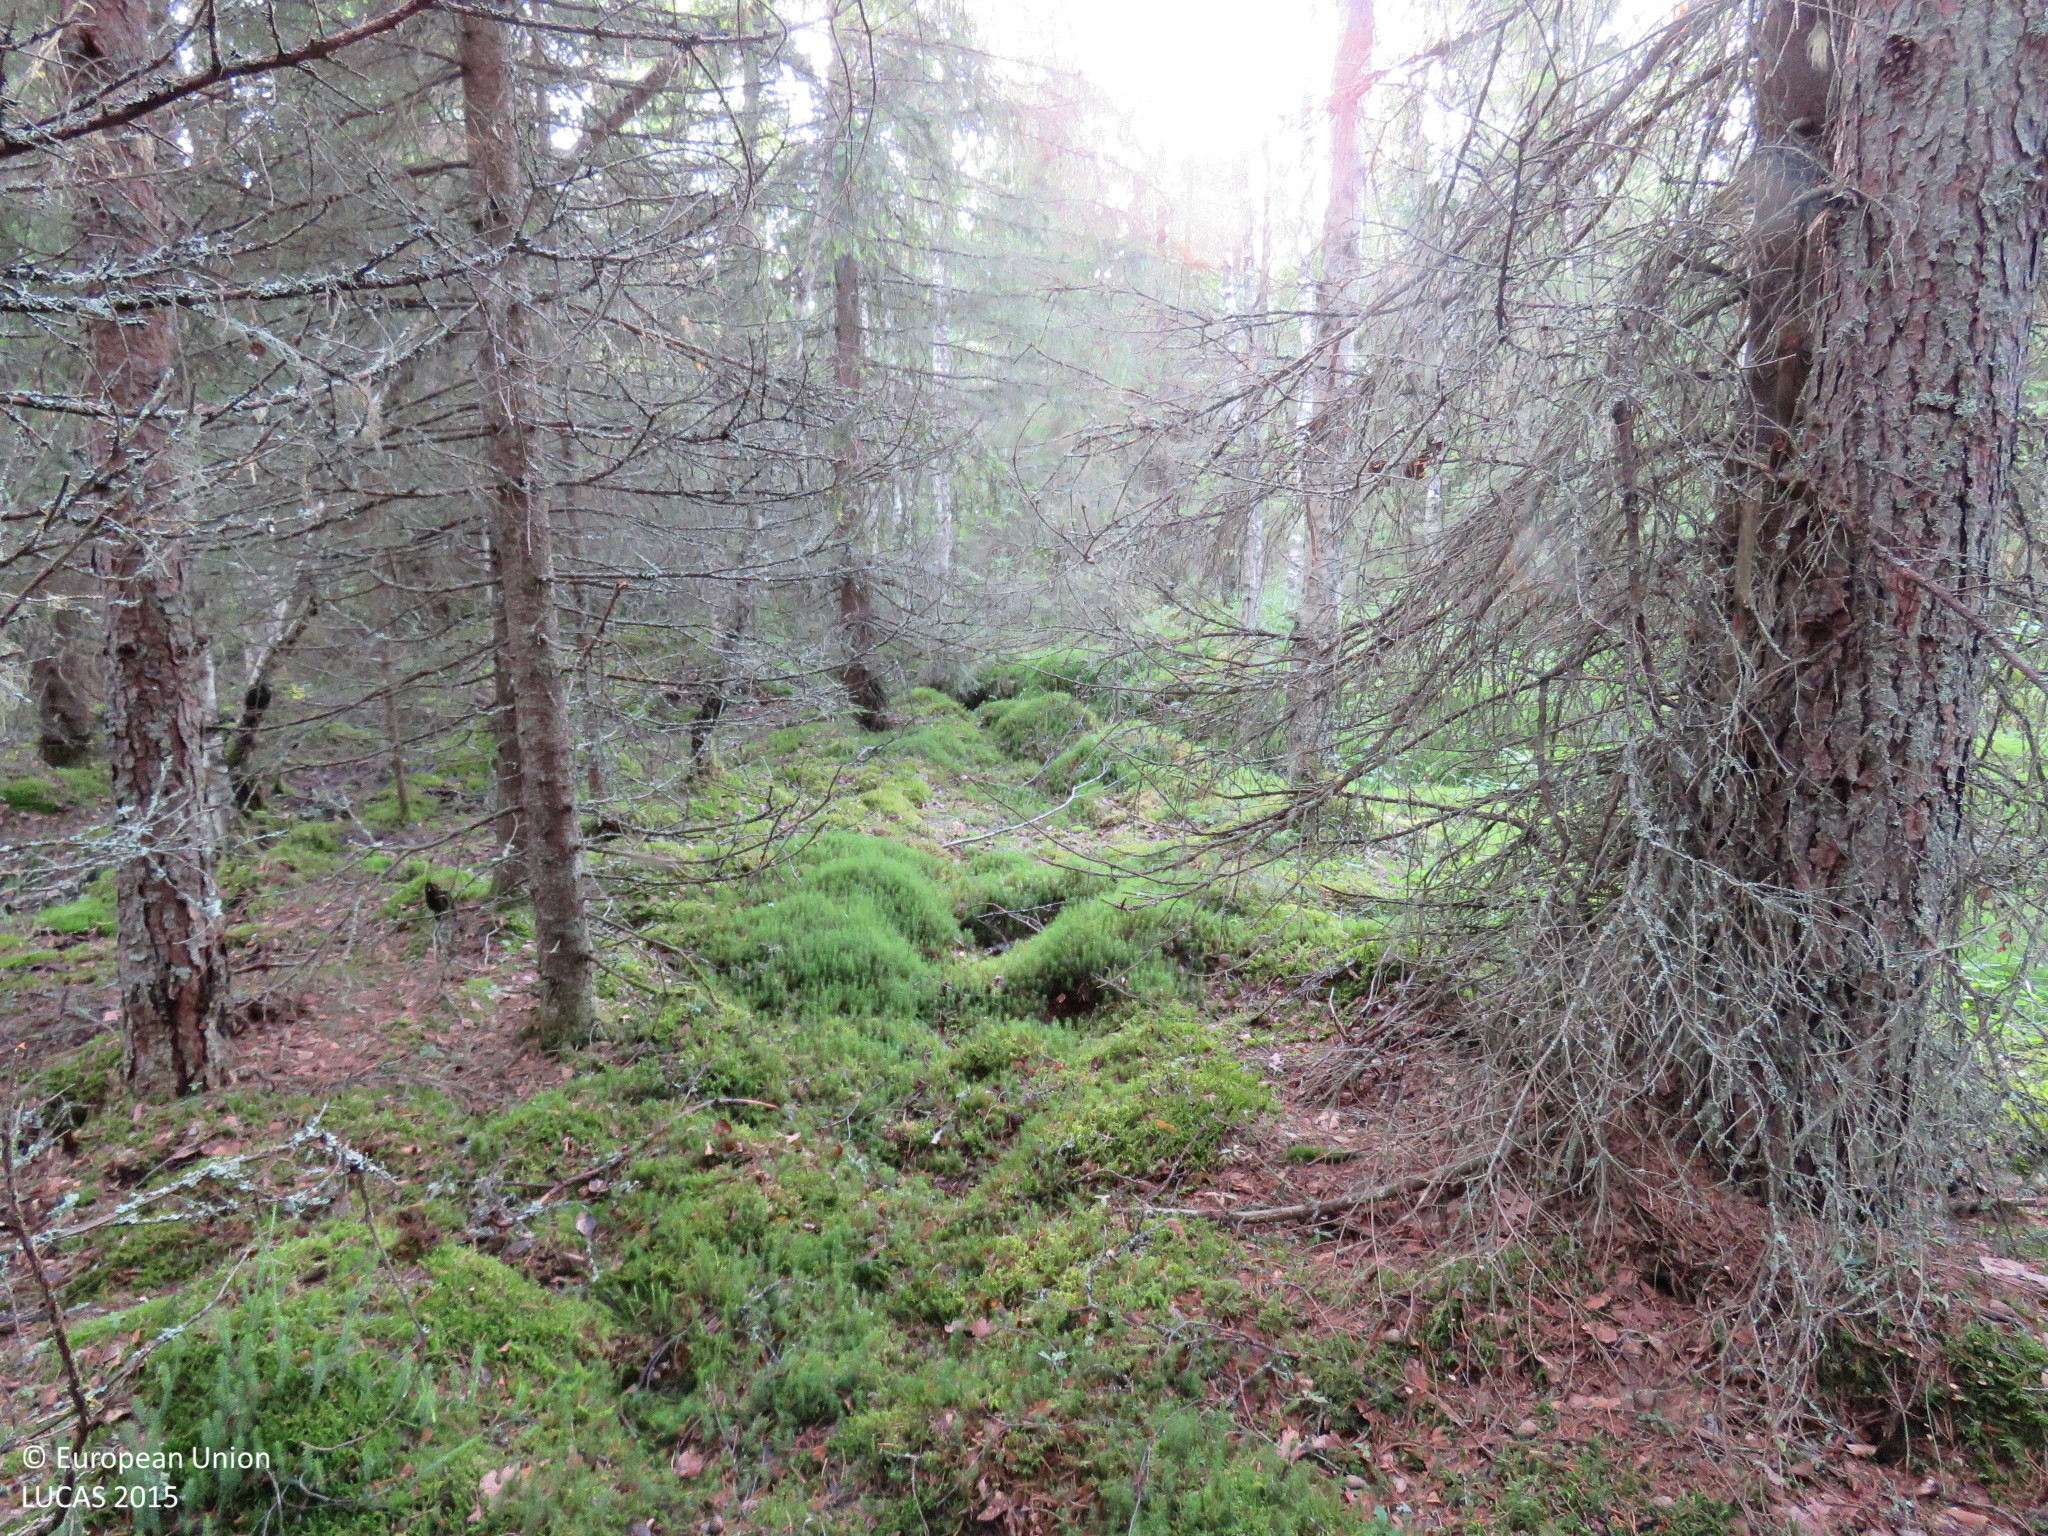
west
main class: Woodland
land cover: Spruce dominated mixed woodland
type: boreal forest
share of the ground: > 75 %
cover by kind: coniferous forest trees 60 %, broadleaved forest trees 25 %, shrubs 10 %, lichens and mosses 5 %
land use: Forestry
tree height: > 5 m
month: July
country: FI
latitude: 64.6028
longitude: 26.3033
